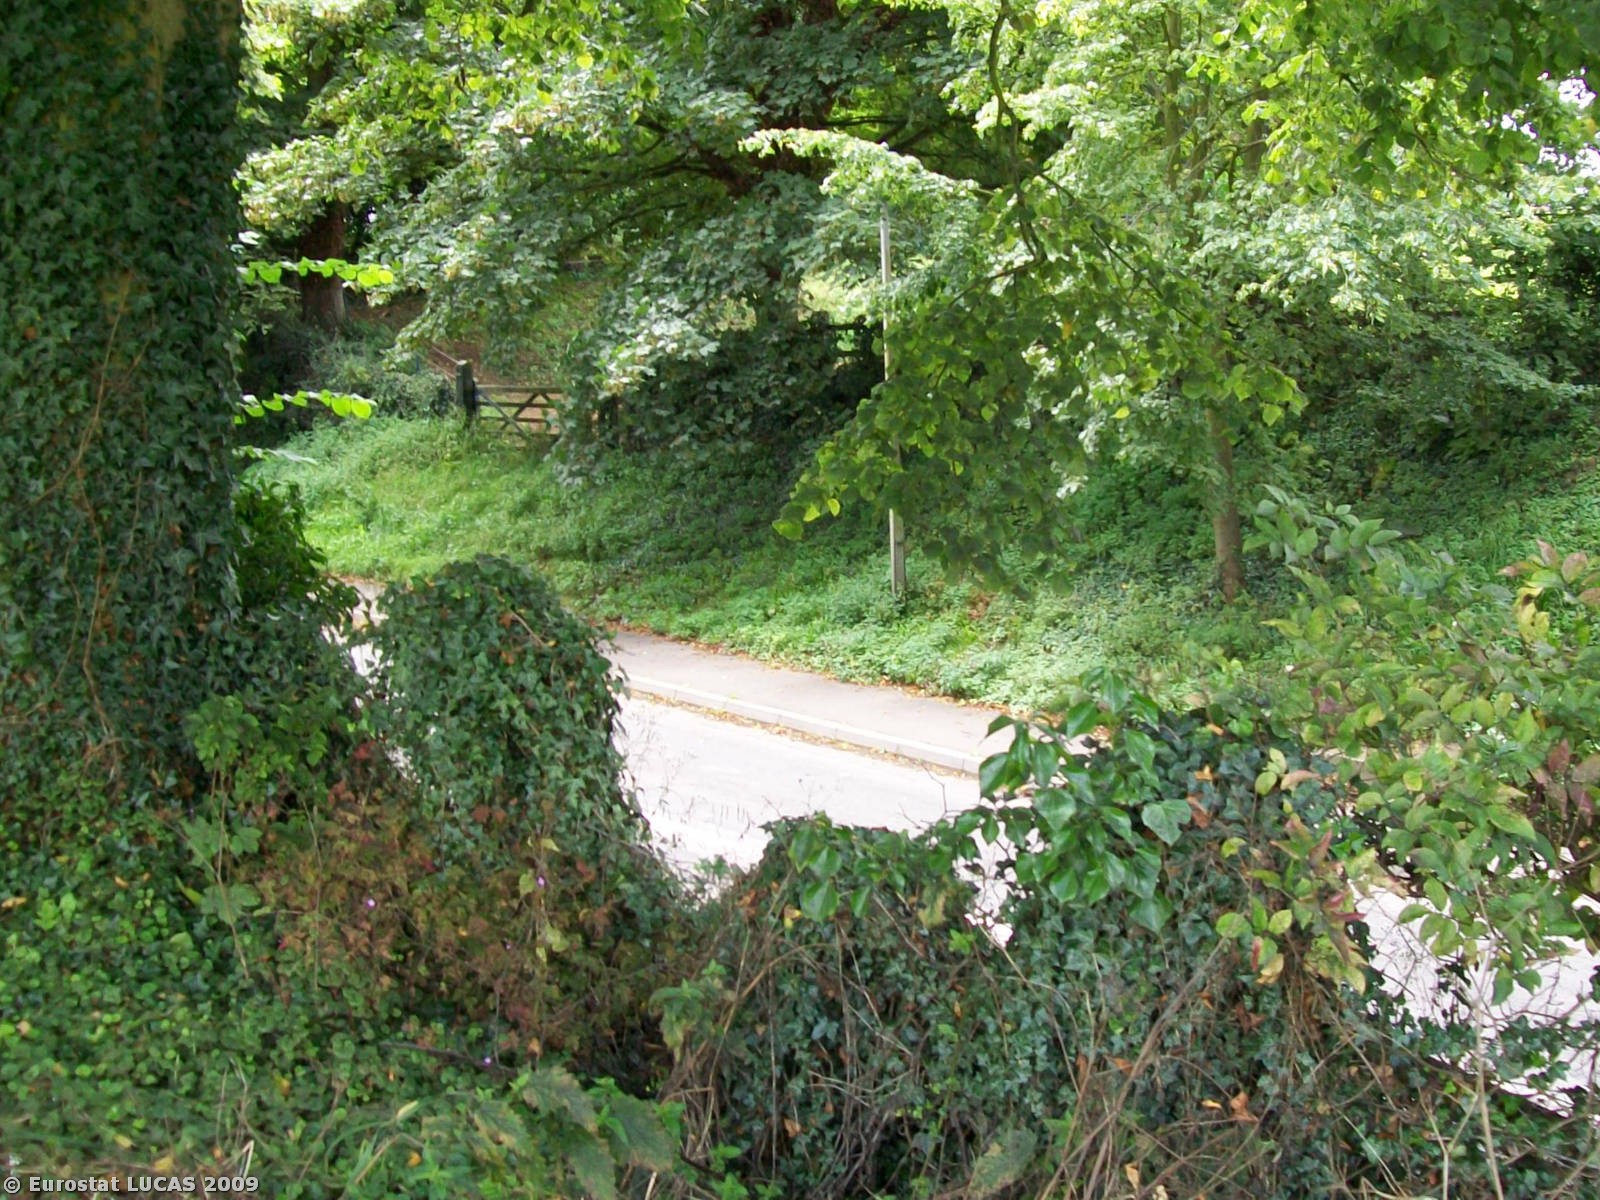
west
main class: Grassland
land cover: Grassland without tree/shrub cover
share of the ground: > 75 %
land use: Agriculture (excluding fallow land and kitchen gardens)
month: August
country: GB
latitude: 53.3082
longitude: -0.8928
